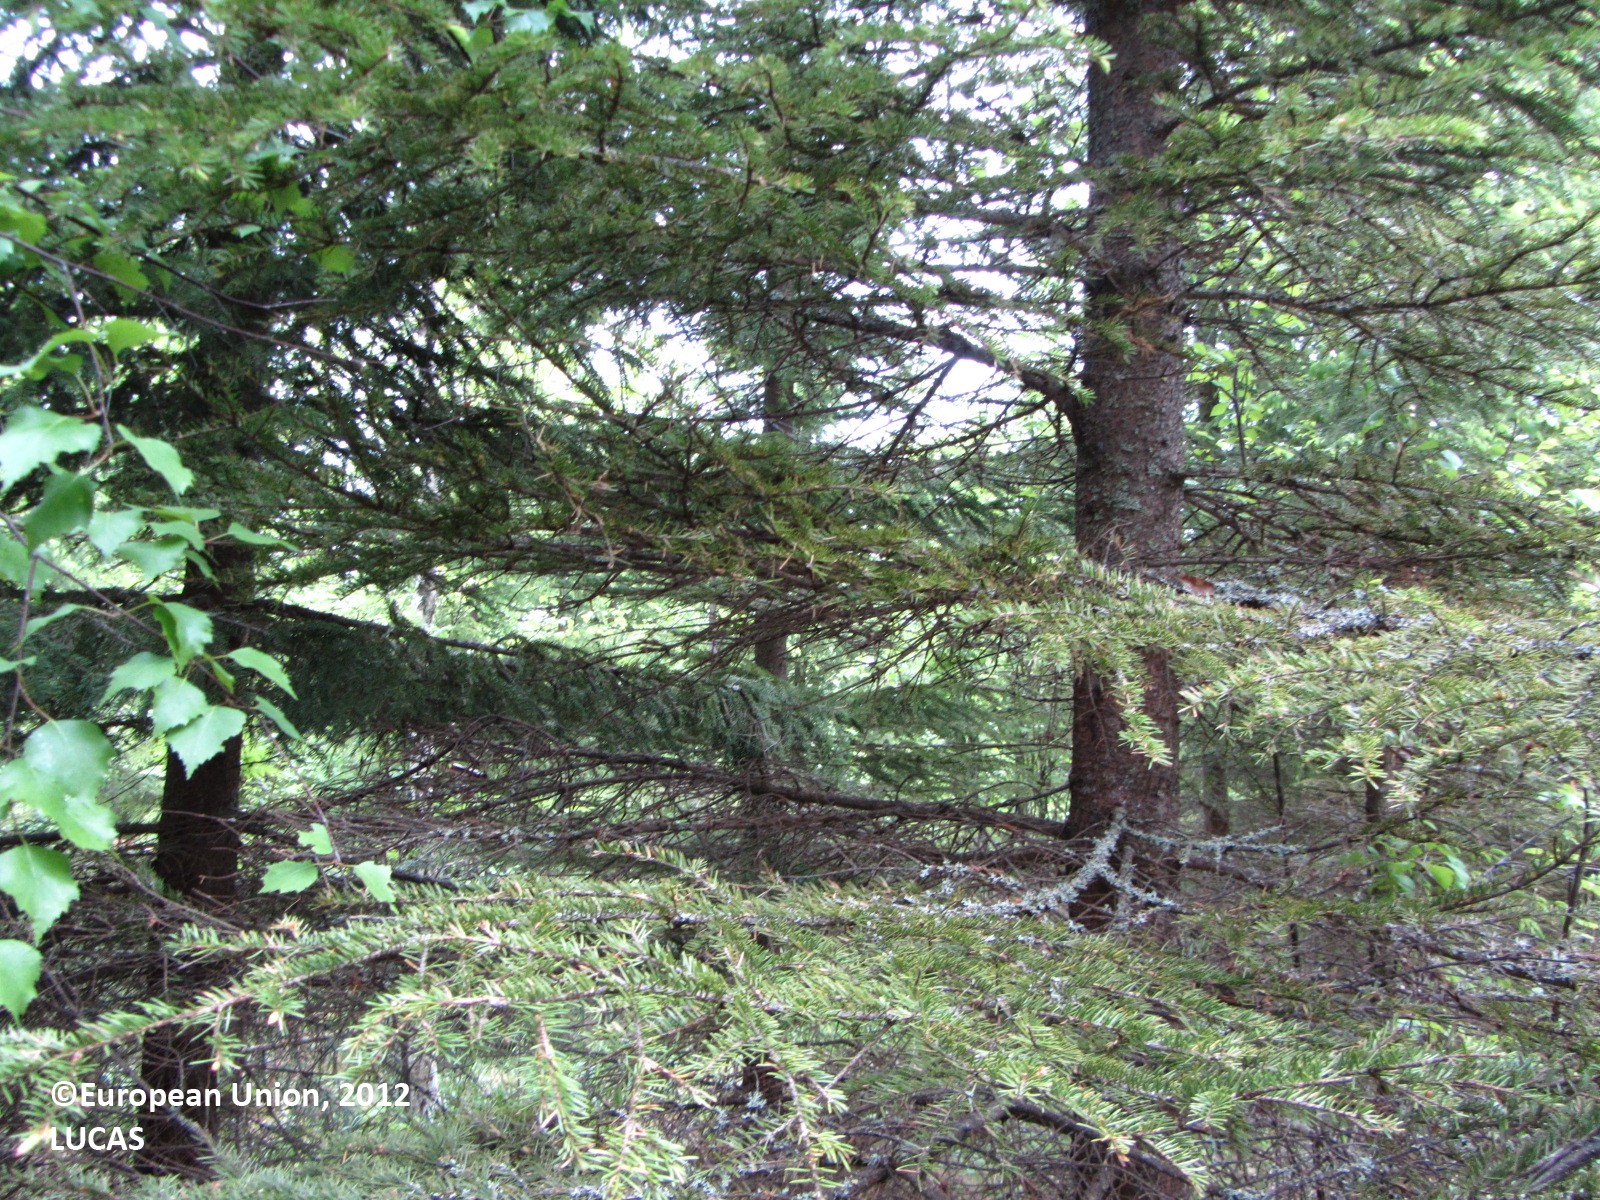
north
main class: Woodland
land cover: Spruce dominated coniferous woodland
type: boreal forest
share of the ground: 50 - 75 %
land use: Forestry
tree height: > 5 m
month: June
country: FI
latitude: 61.7722
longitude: 24.9068
